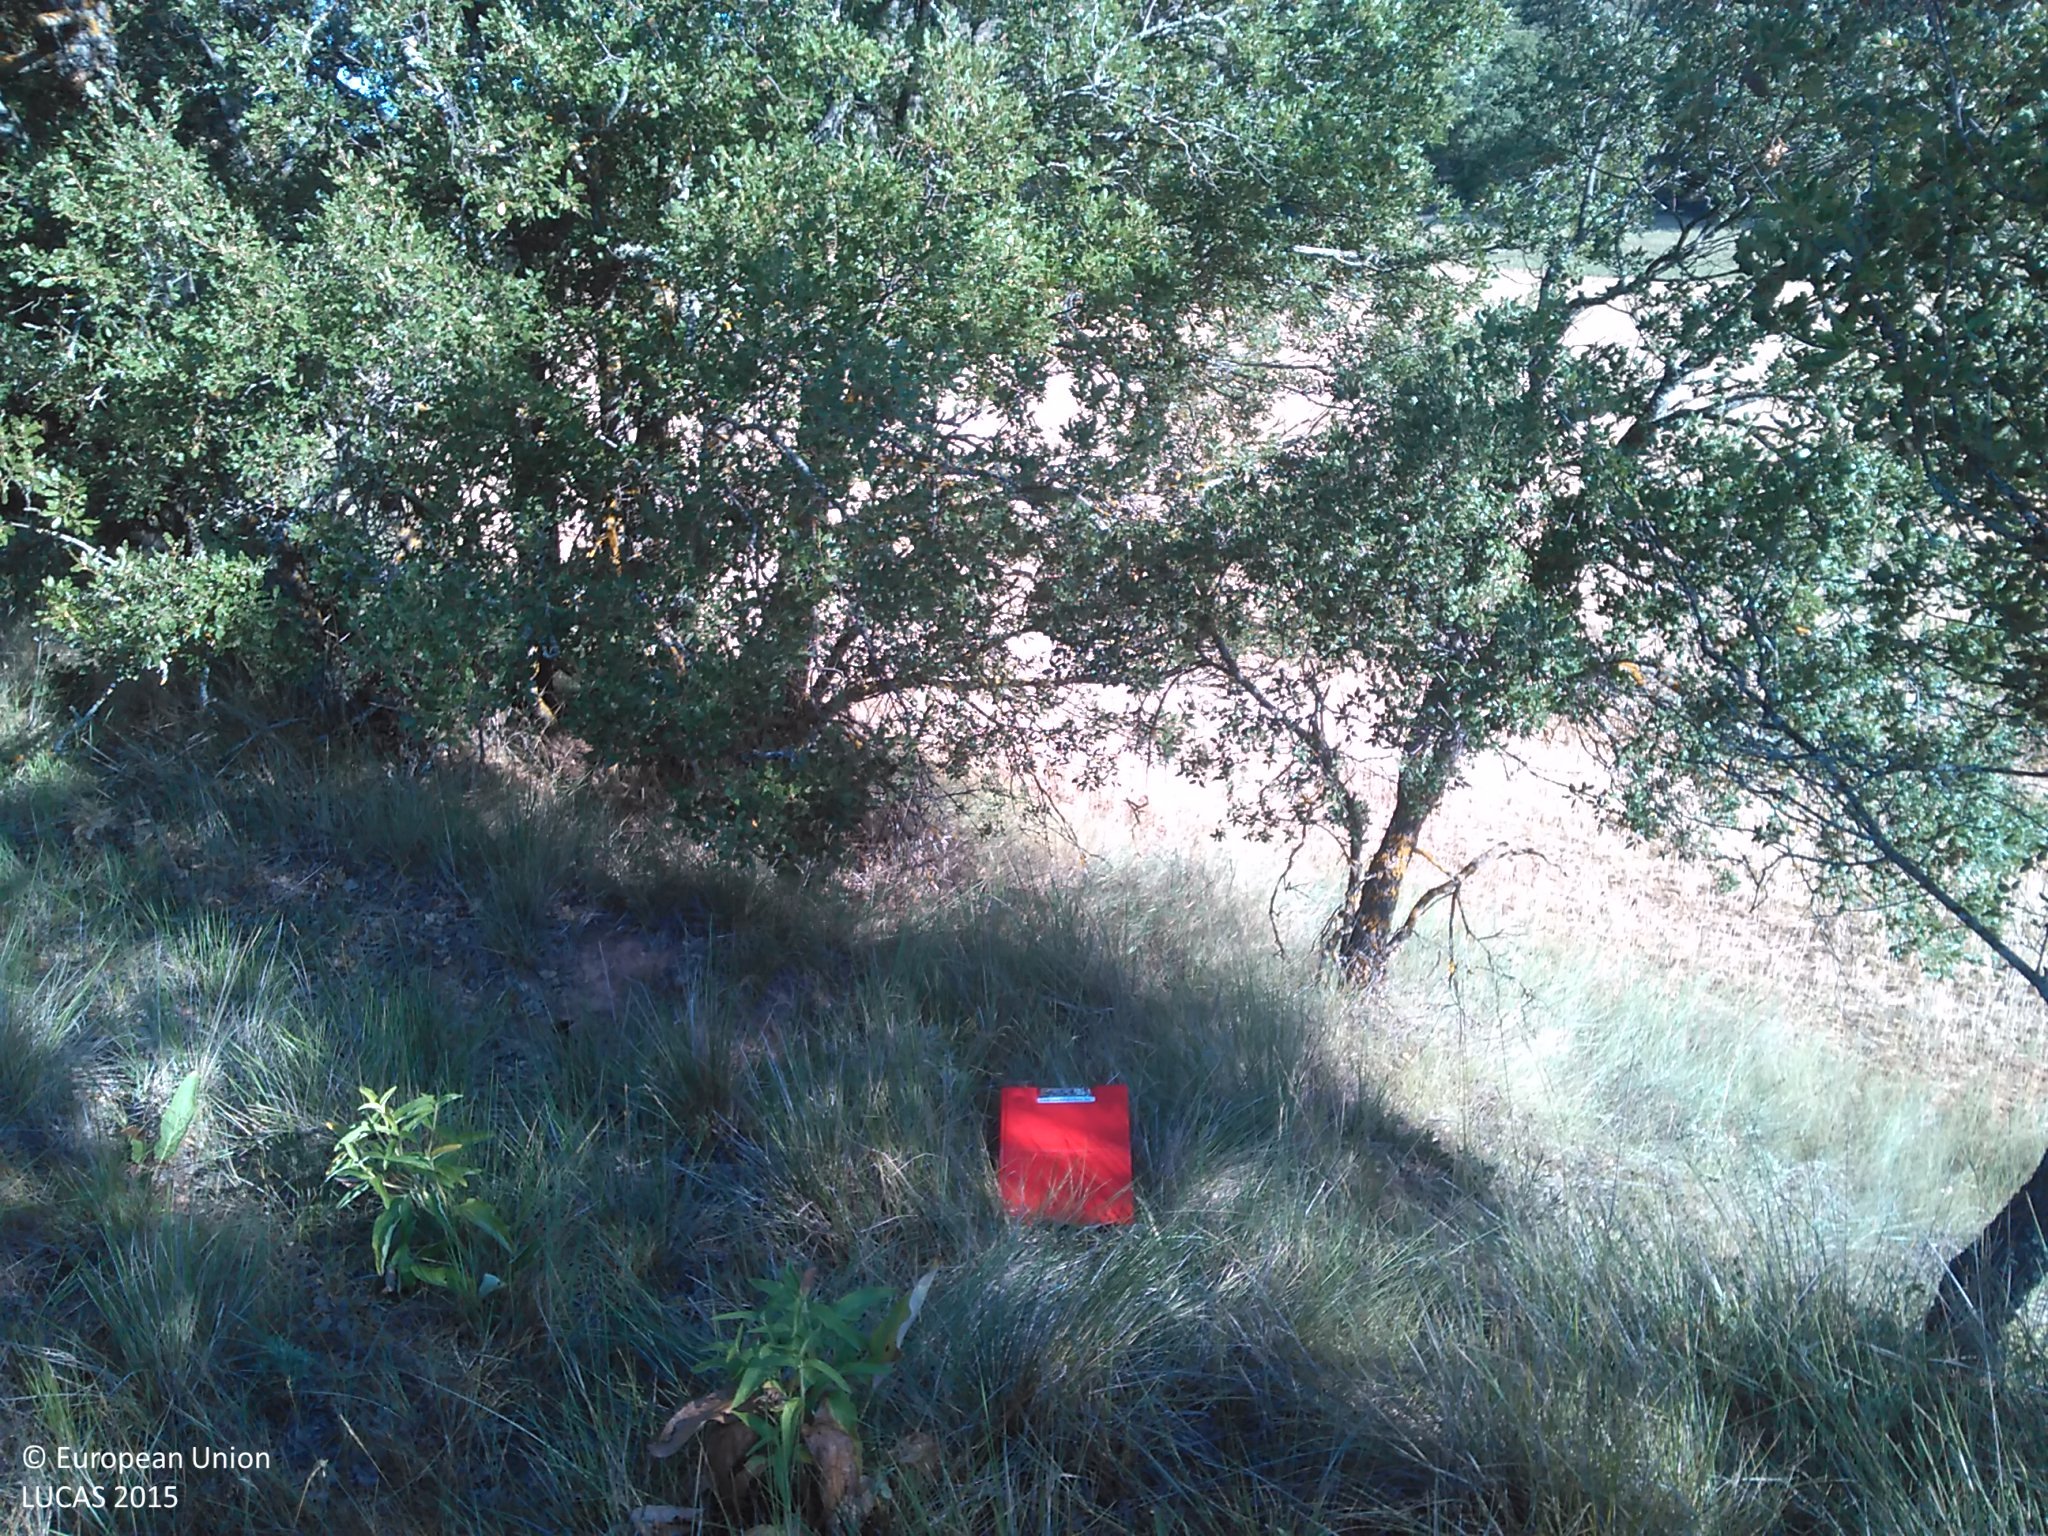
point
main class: Woodland
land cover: Broadleaved woodland
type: broadleaved evergreen forest
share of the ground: 25 - 50 %
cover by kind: broadleaved forest trees 40 %, herbaceous plants 35 %, unconsolidated bare surface 20 %, shrubs 5 %
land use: Semi-natural and natural areas not in use
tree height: > 5 m
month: July
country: ES
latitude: 41.5008
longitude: -2.1431
